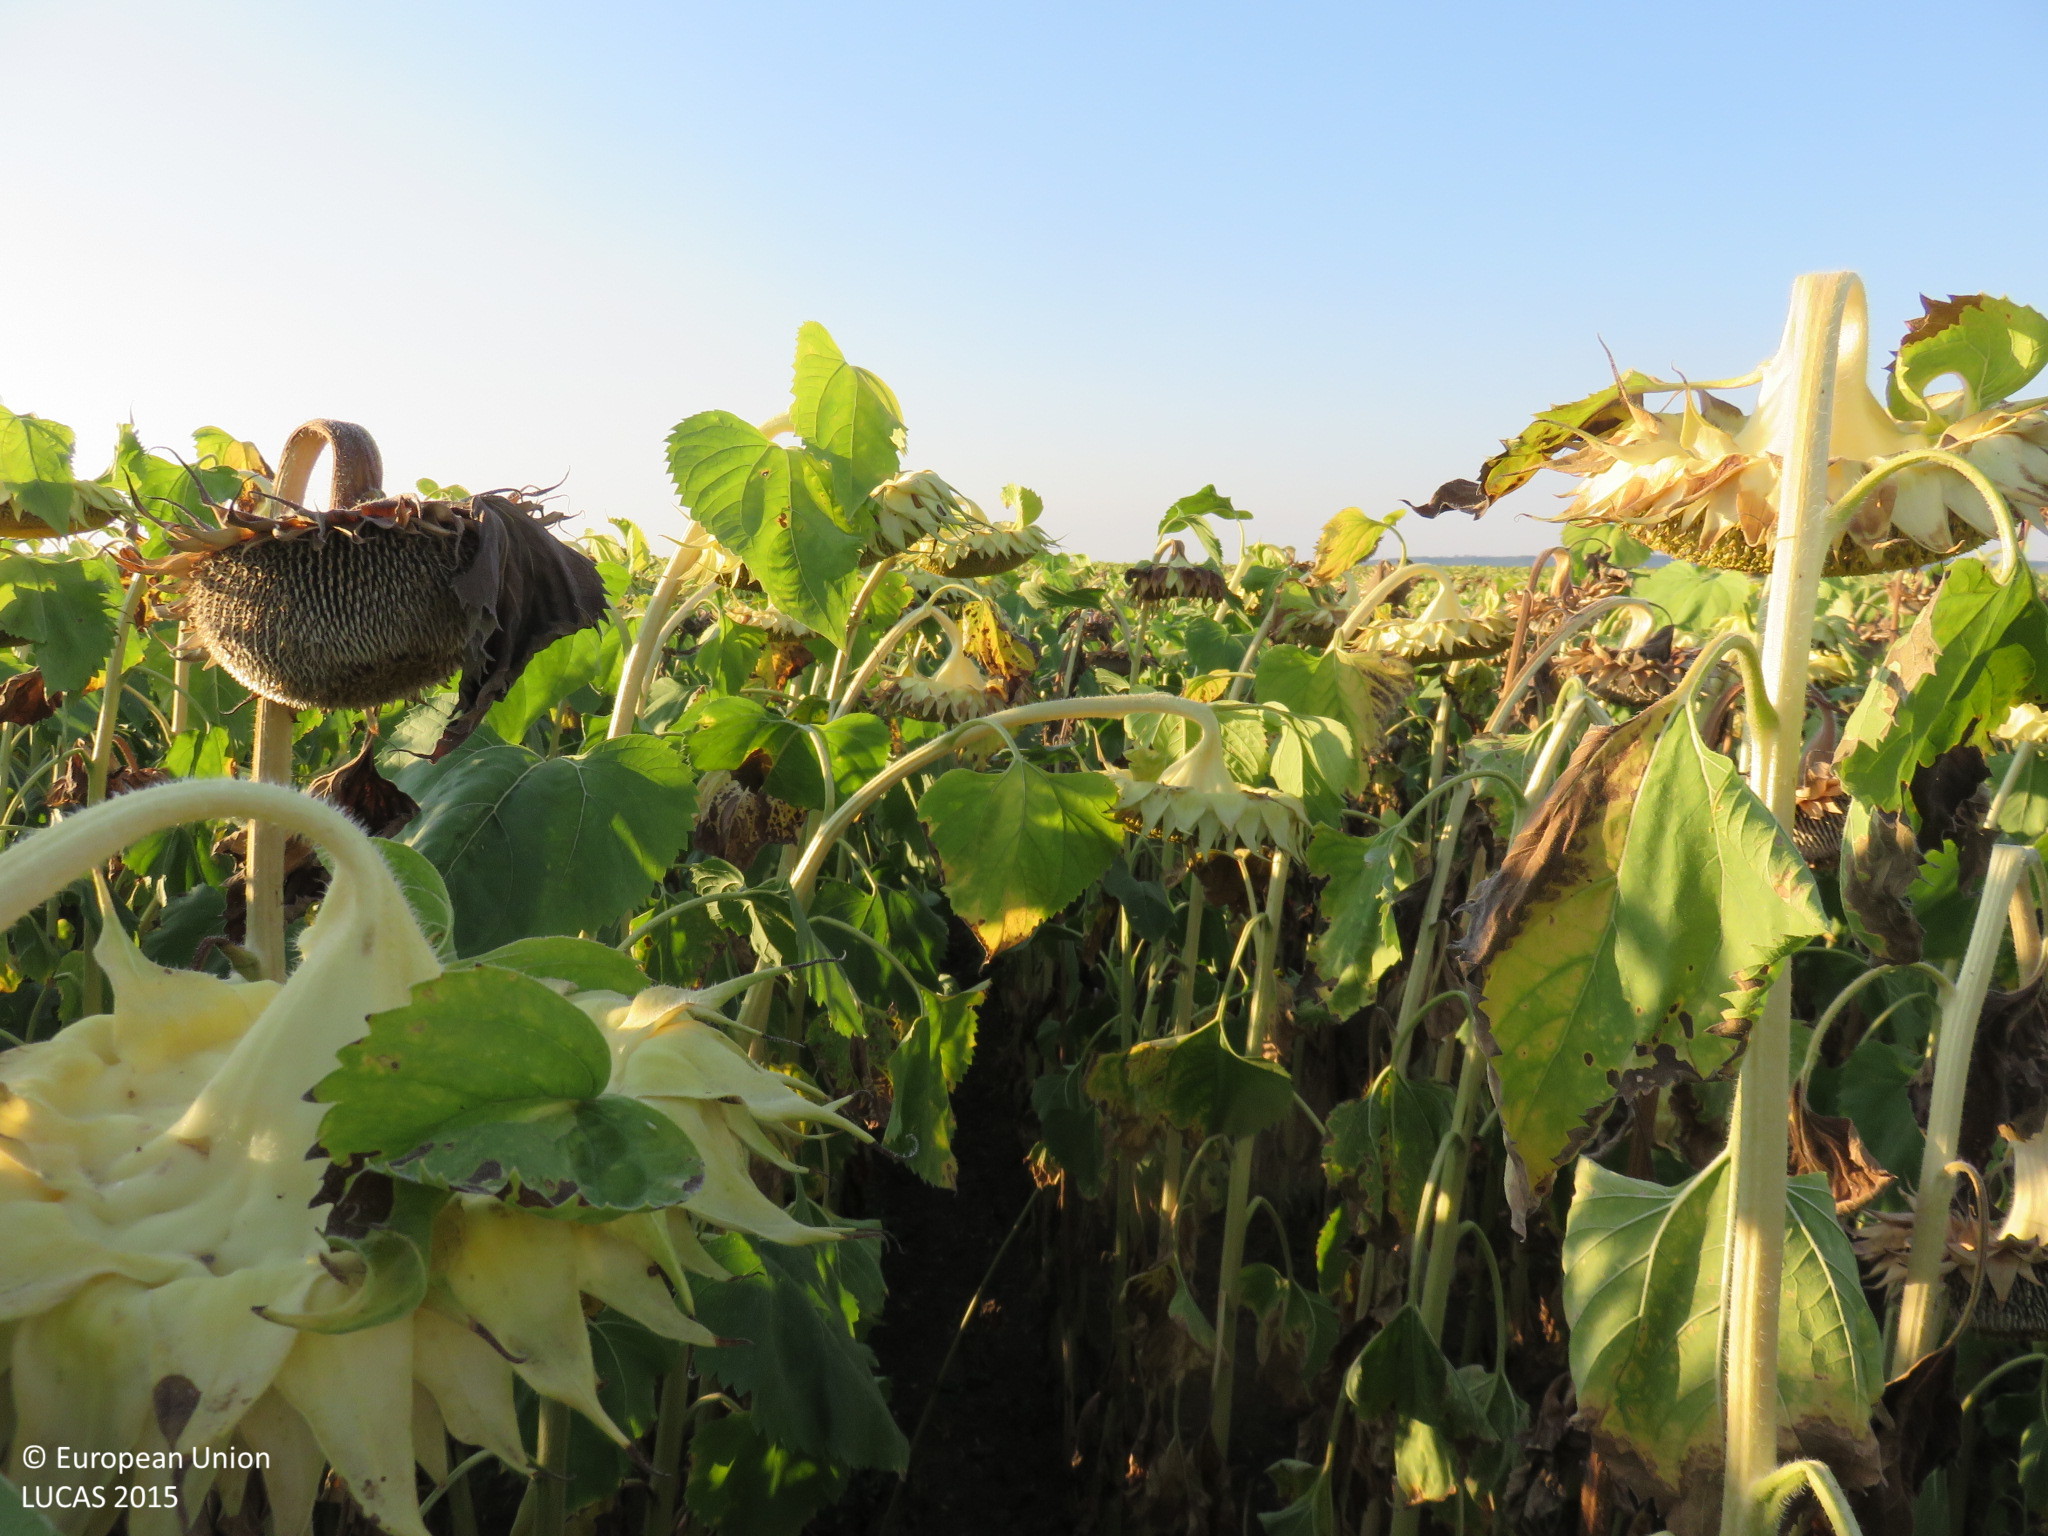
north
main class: Cropland
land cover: Sunflower
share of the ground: > 75 %
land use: Agriculture (excluding fallow land and kitchen gardens)
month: July
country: BG
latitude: 43.3642
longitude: 25.1143
